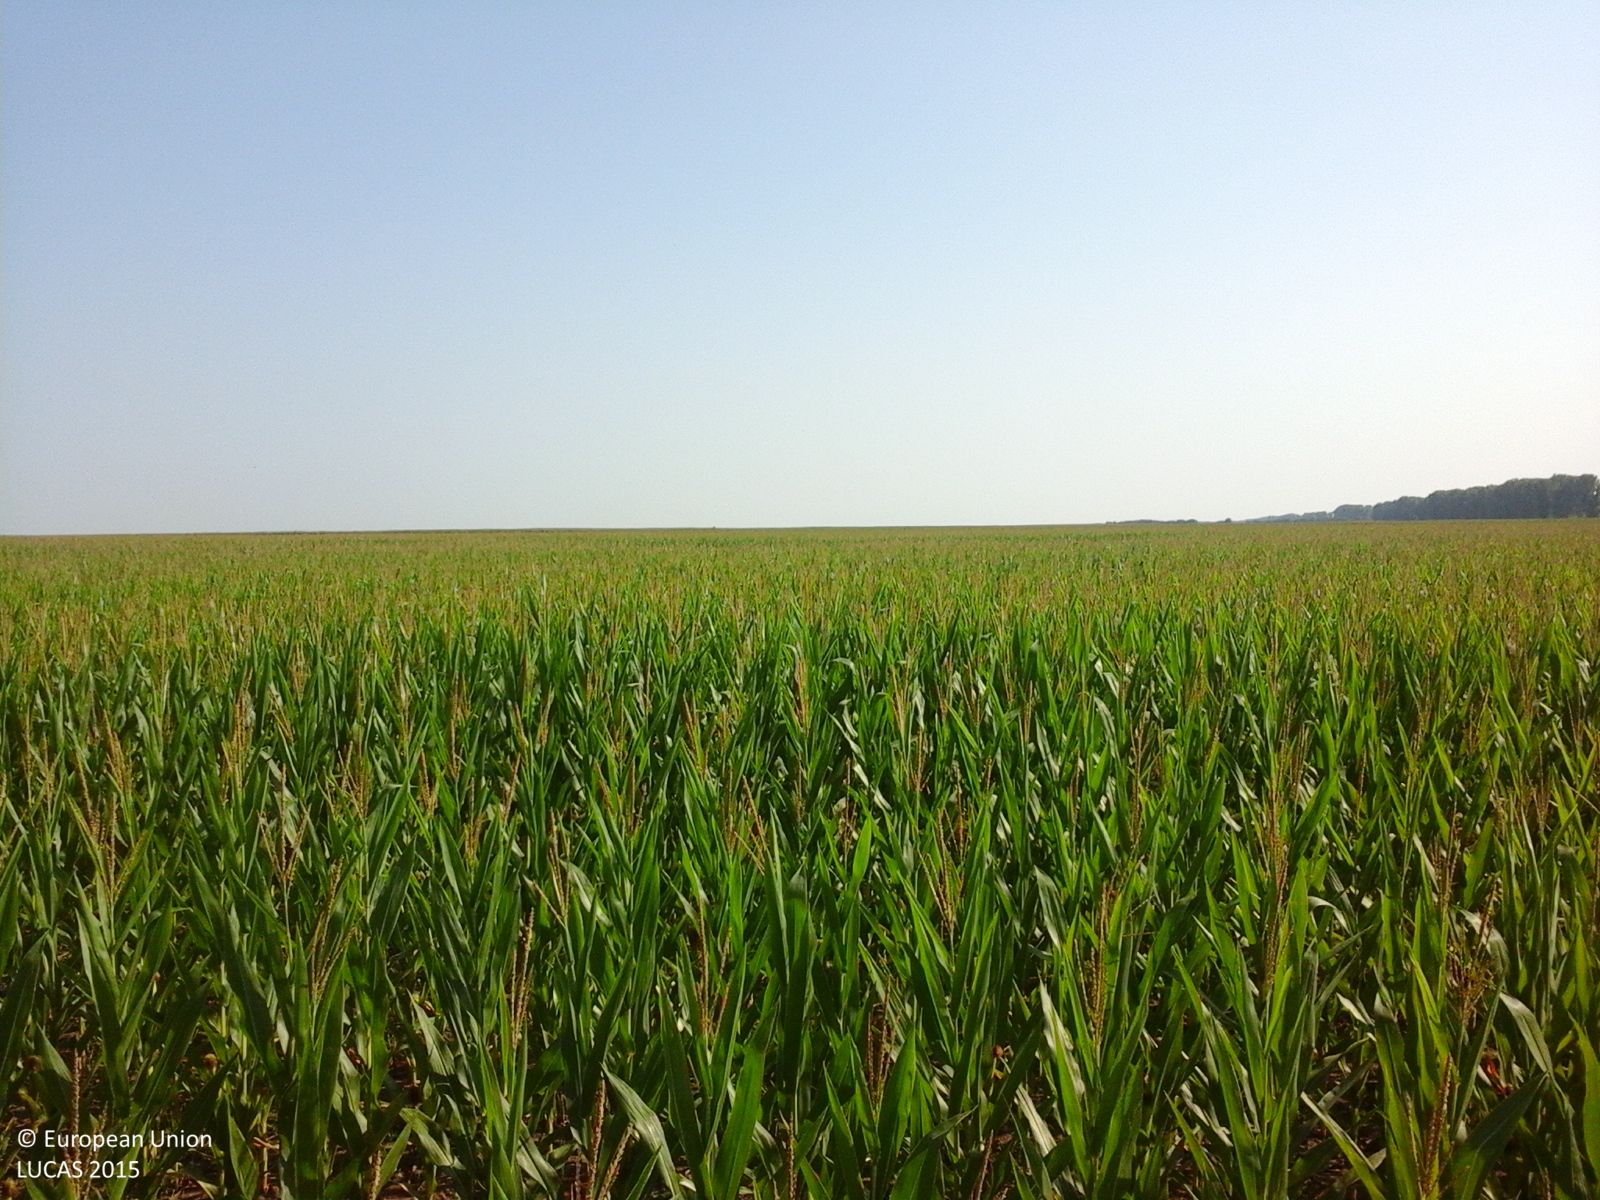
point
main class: Cropland
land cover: Maize
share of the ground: > 75 %
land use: Agriculture (excluding fallow land and kitchen gardens)
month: July
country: RO
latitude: 44.8943
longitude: 27.1690
